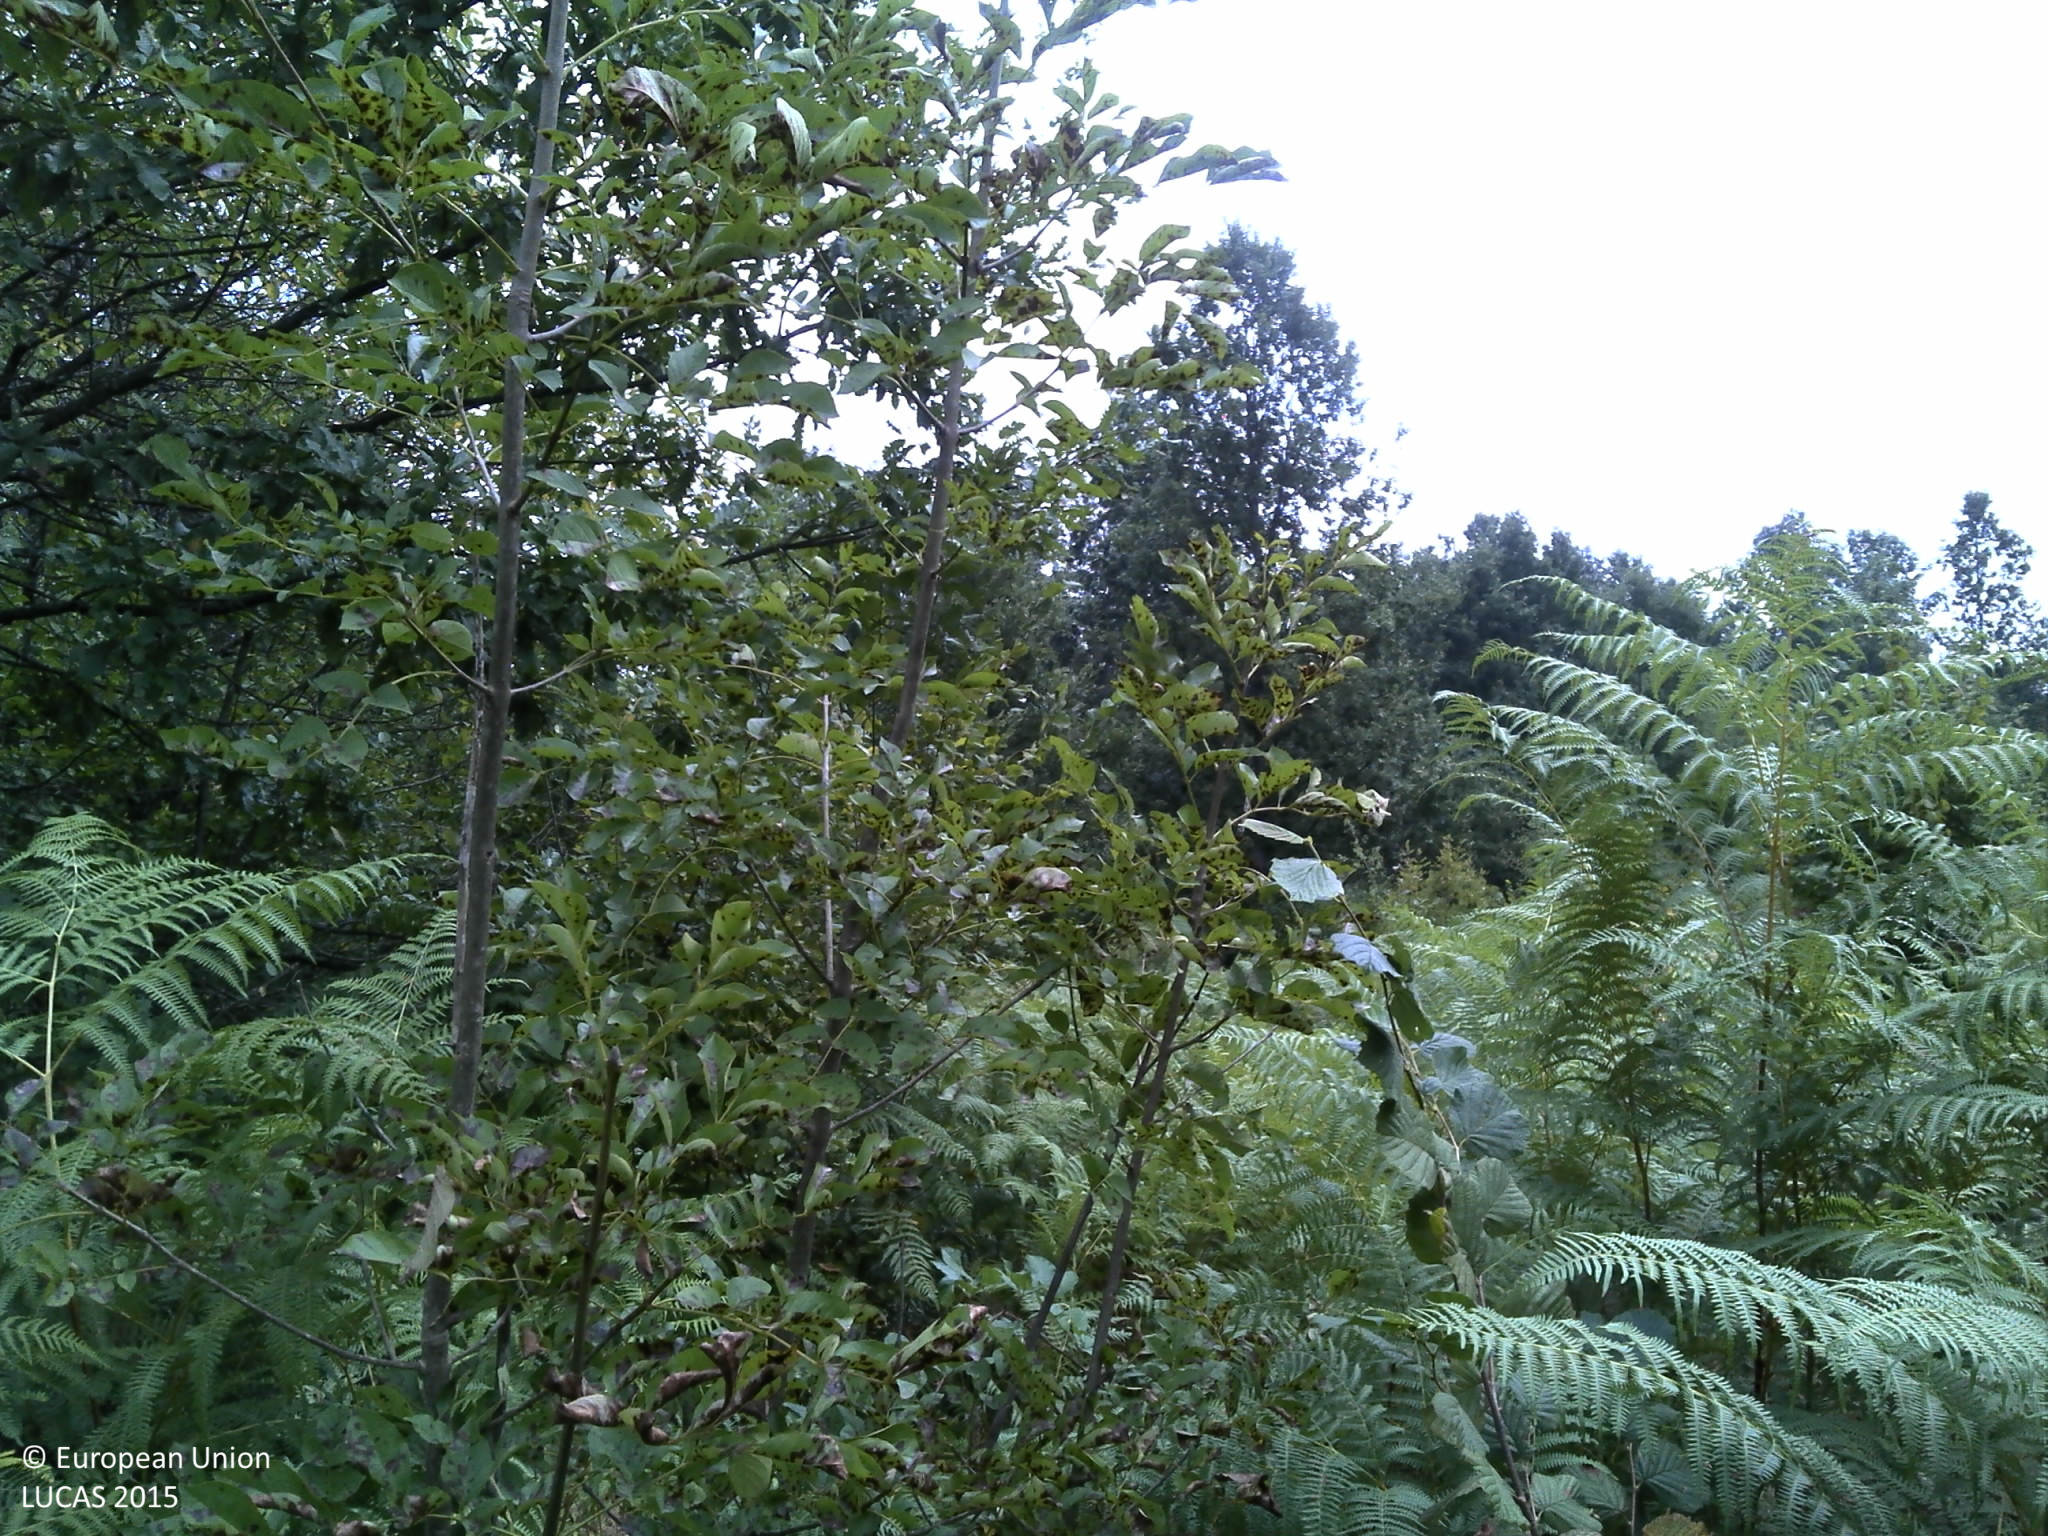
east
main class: Shrubland
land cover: Shrubland with sparse tree cover
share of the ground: > 75 %
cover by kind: shrubs 85 %, herbaceous plants 10 %, broadleaved forest trees 5 %
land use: Semi-natural and natural areas not in use
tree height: < 5 m
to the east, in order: Shrubland with sparse tree cover; Broadleaved woodland; Shrubland with sparse tree cover; Broadleaved woodland; Shrubland with sparse tree cover; Tracks; Grassland with sparse tree/shrub cover; Tracks; Shrubland with sparse tree cover
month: September
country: HR
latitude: 45.1568
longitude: 15.6052
